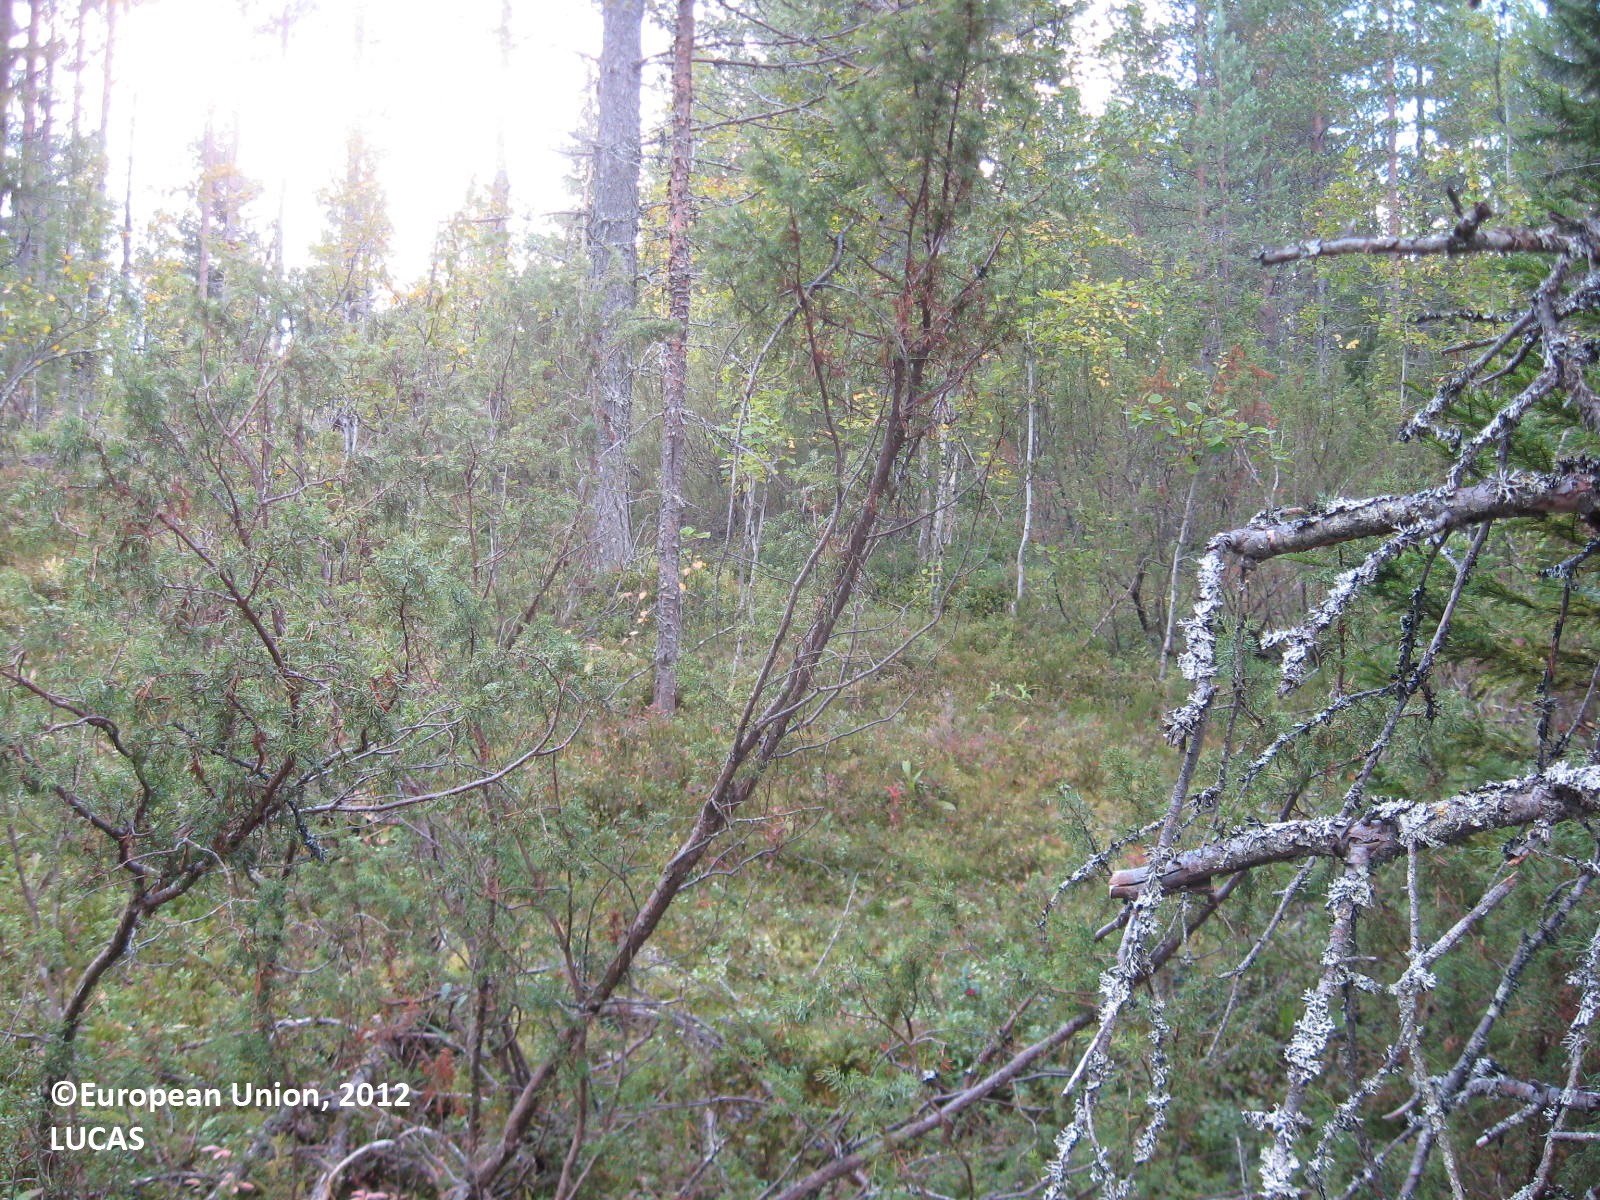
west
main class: Woodland
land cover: Other coniferous woodland
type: boreal forest
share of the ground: > 75 %
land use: Forestry
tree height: > 5 m
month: August
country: FI
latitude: 63.9477
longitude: 29.8472
